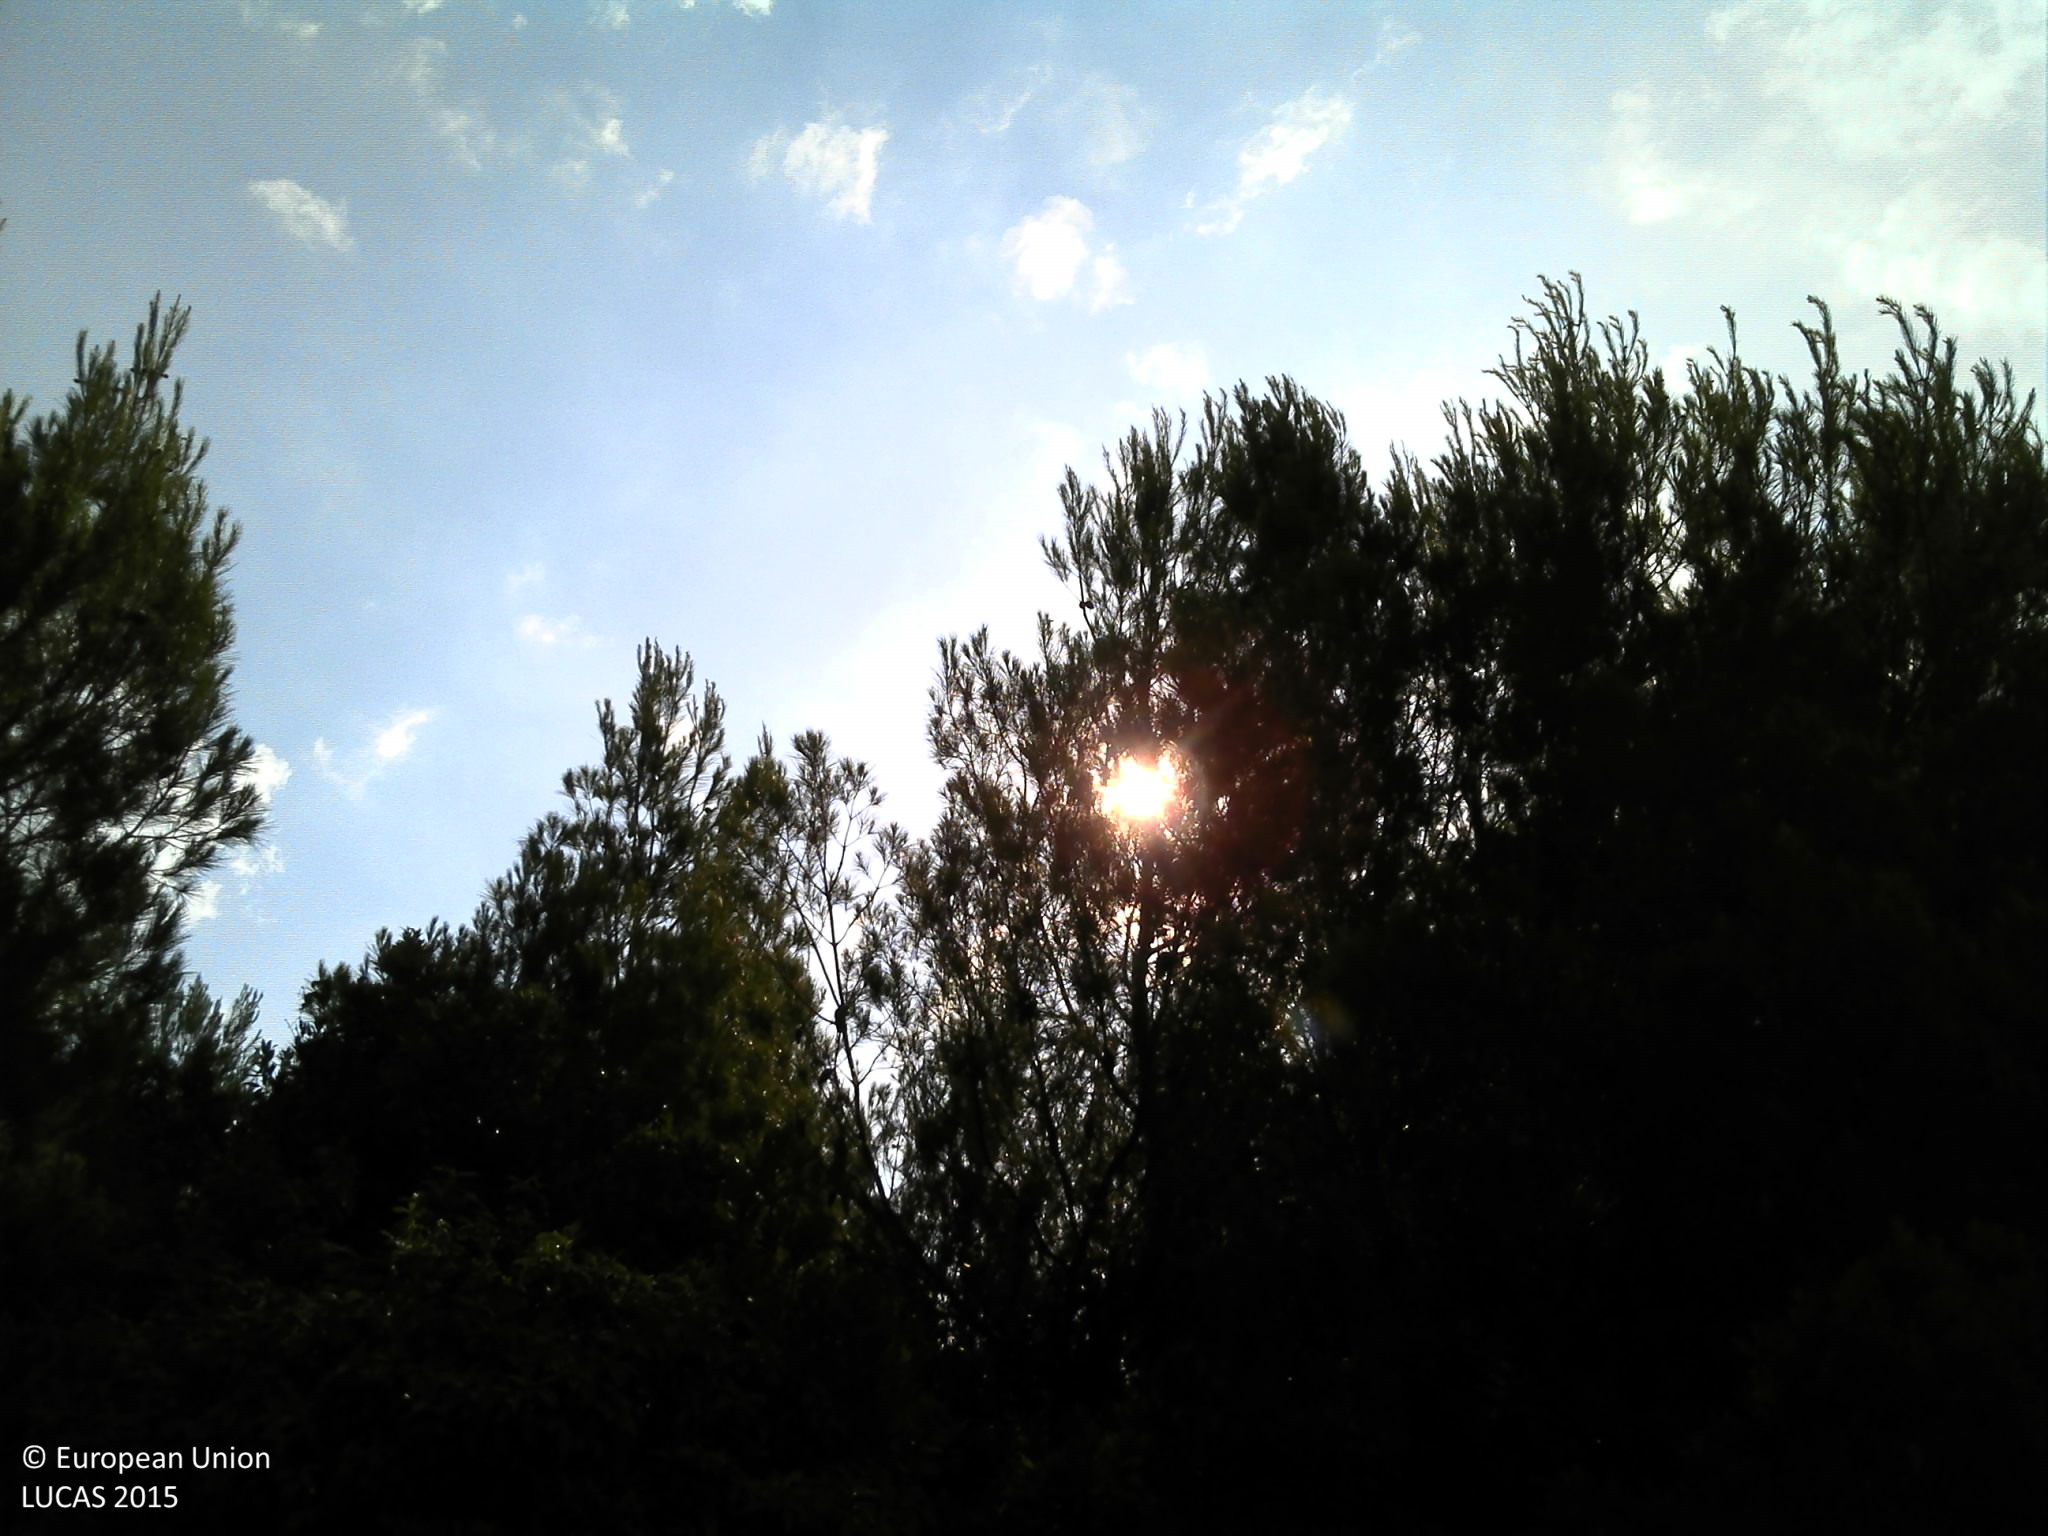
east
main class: Cropland
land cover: Olive groves
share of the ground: 25 - 50 %
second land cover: Vineyards
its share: 10 - 25 %
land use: Agriculture (excluding fallow land and kitchen gardens)
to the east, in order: Olive groves; Vineyards; Pine dominated coniferous woodland; Spruce dominated mixed woodland; Shrubland without tree cover; Spruce dominated mixed woodland
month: July
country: HR
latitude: 42.9069
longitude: 17.4245
